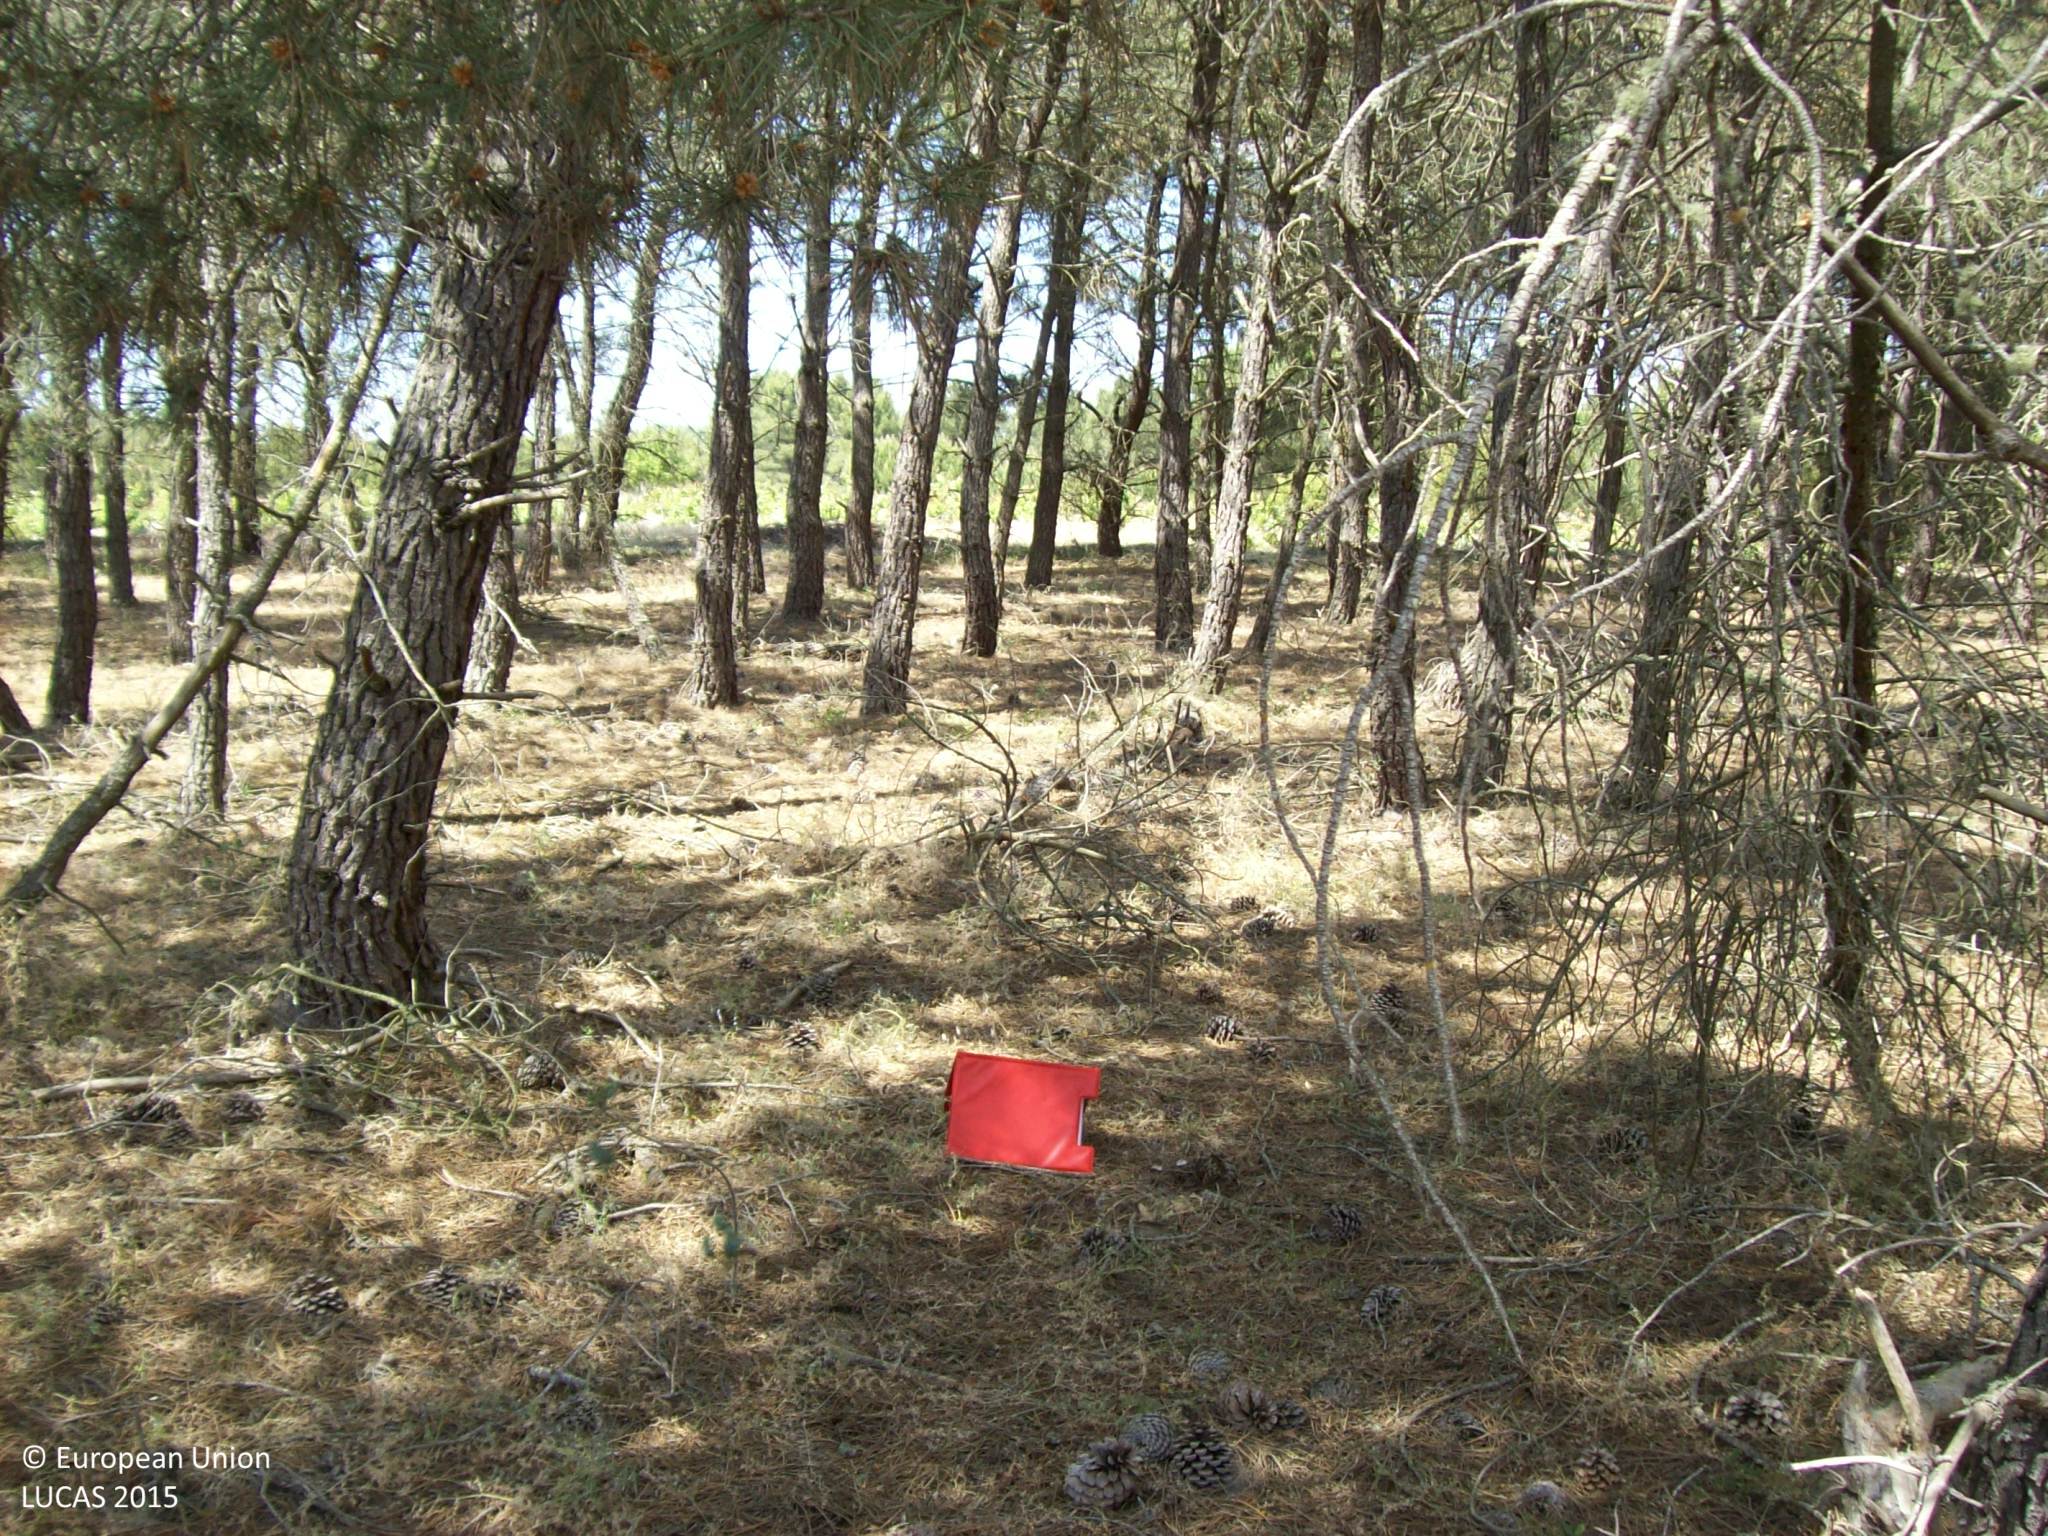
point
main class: Woodland
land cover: Pine dominated coniferous woodland
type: coniferous forest of the mediterranean region
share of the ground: 50 - 75 %
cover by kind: coniferous forest trees 60 %, unconsolidated bare surface 30 %, herbaceous plants 5 %, lichens and mosses 5 %
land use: Forestry
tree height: > 5 m
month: June
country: ES
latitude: 41.1588
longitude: -4.5389
